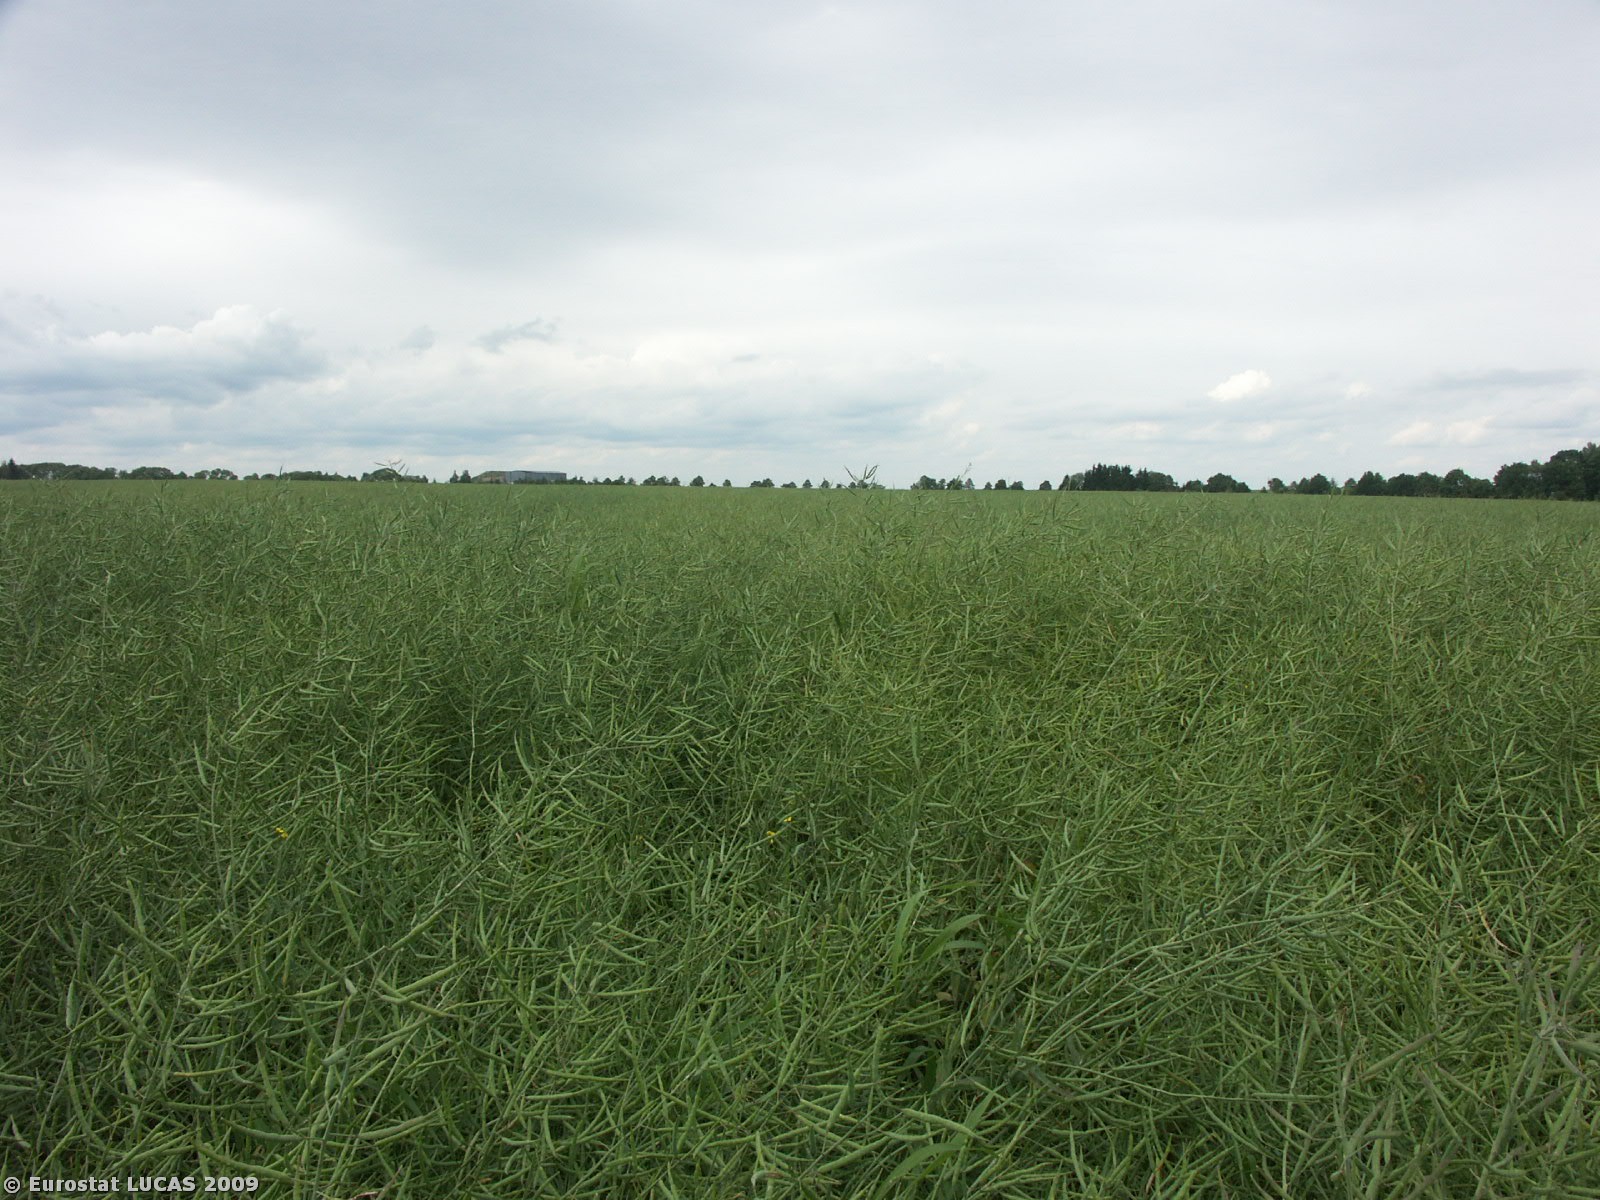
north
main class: Cropland
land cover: Rape and turnip rape
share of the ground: > 75 %
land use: Agriculture (excluding fallow land and kitchen gardens)
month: June
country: CZ
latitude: 49.0091
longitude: 14.6360
